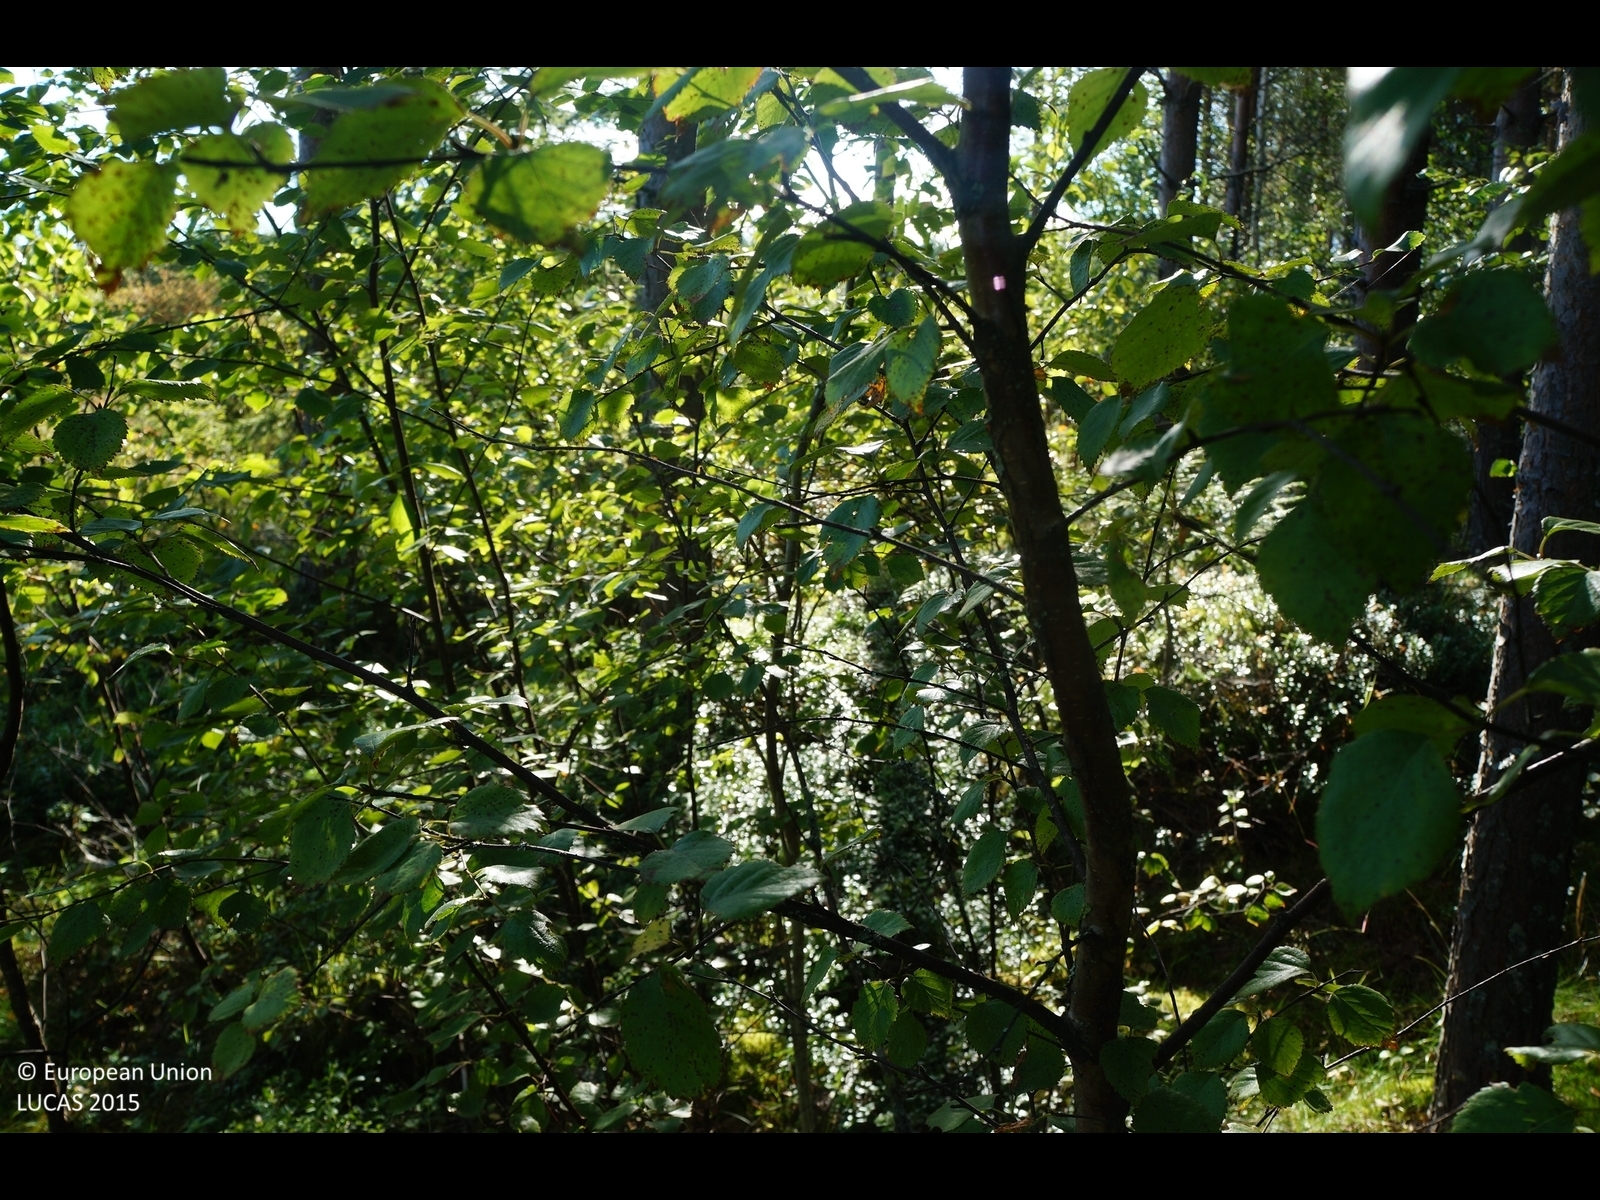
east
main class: Woodland
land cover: Pine dominated coniferous woodland
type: boreal forest
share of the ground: 50 - 75 %
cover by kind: coniferous forest trees 50 %, shrubs 35 %, lichens and mosses 10 %, herbaceous plants 5 %
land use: Forestry
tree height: > 5 m
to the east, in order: Pine dominated coniferous woodland; Ditches and canals; Abandoned hedges; Tracks; Shruby margins; Ditches and canals; Shruby margins; Temporary grasslands; Broadleaved woodland; Temporary grasslands; Shruby margins; Ditches and canals; Shruby margins; Tracks; Abandoned hedges; Ditches and canals; Pine dominated coniferous woodland; Ditches and canals; Pine dominated mixed woodland; Ditches and canals; Pine dominated mixed woodland; Ditches and canals; Pine dominated coniferous woodland; Ditches and canals; Pine dominated coniferous woodland; Ditches and canals; Spruce dominated mixed woodland; Ditches and canals; Other coniferous woodland
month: August
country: FI
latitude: 64.8757
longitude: 25.0415
